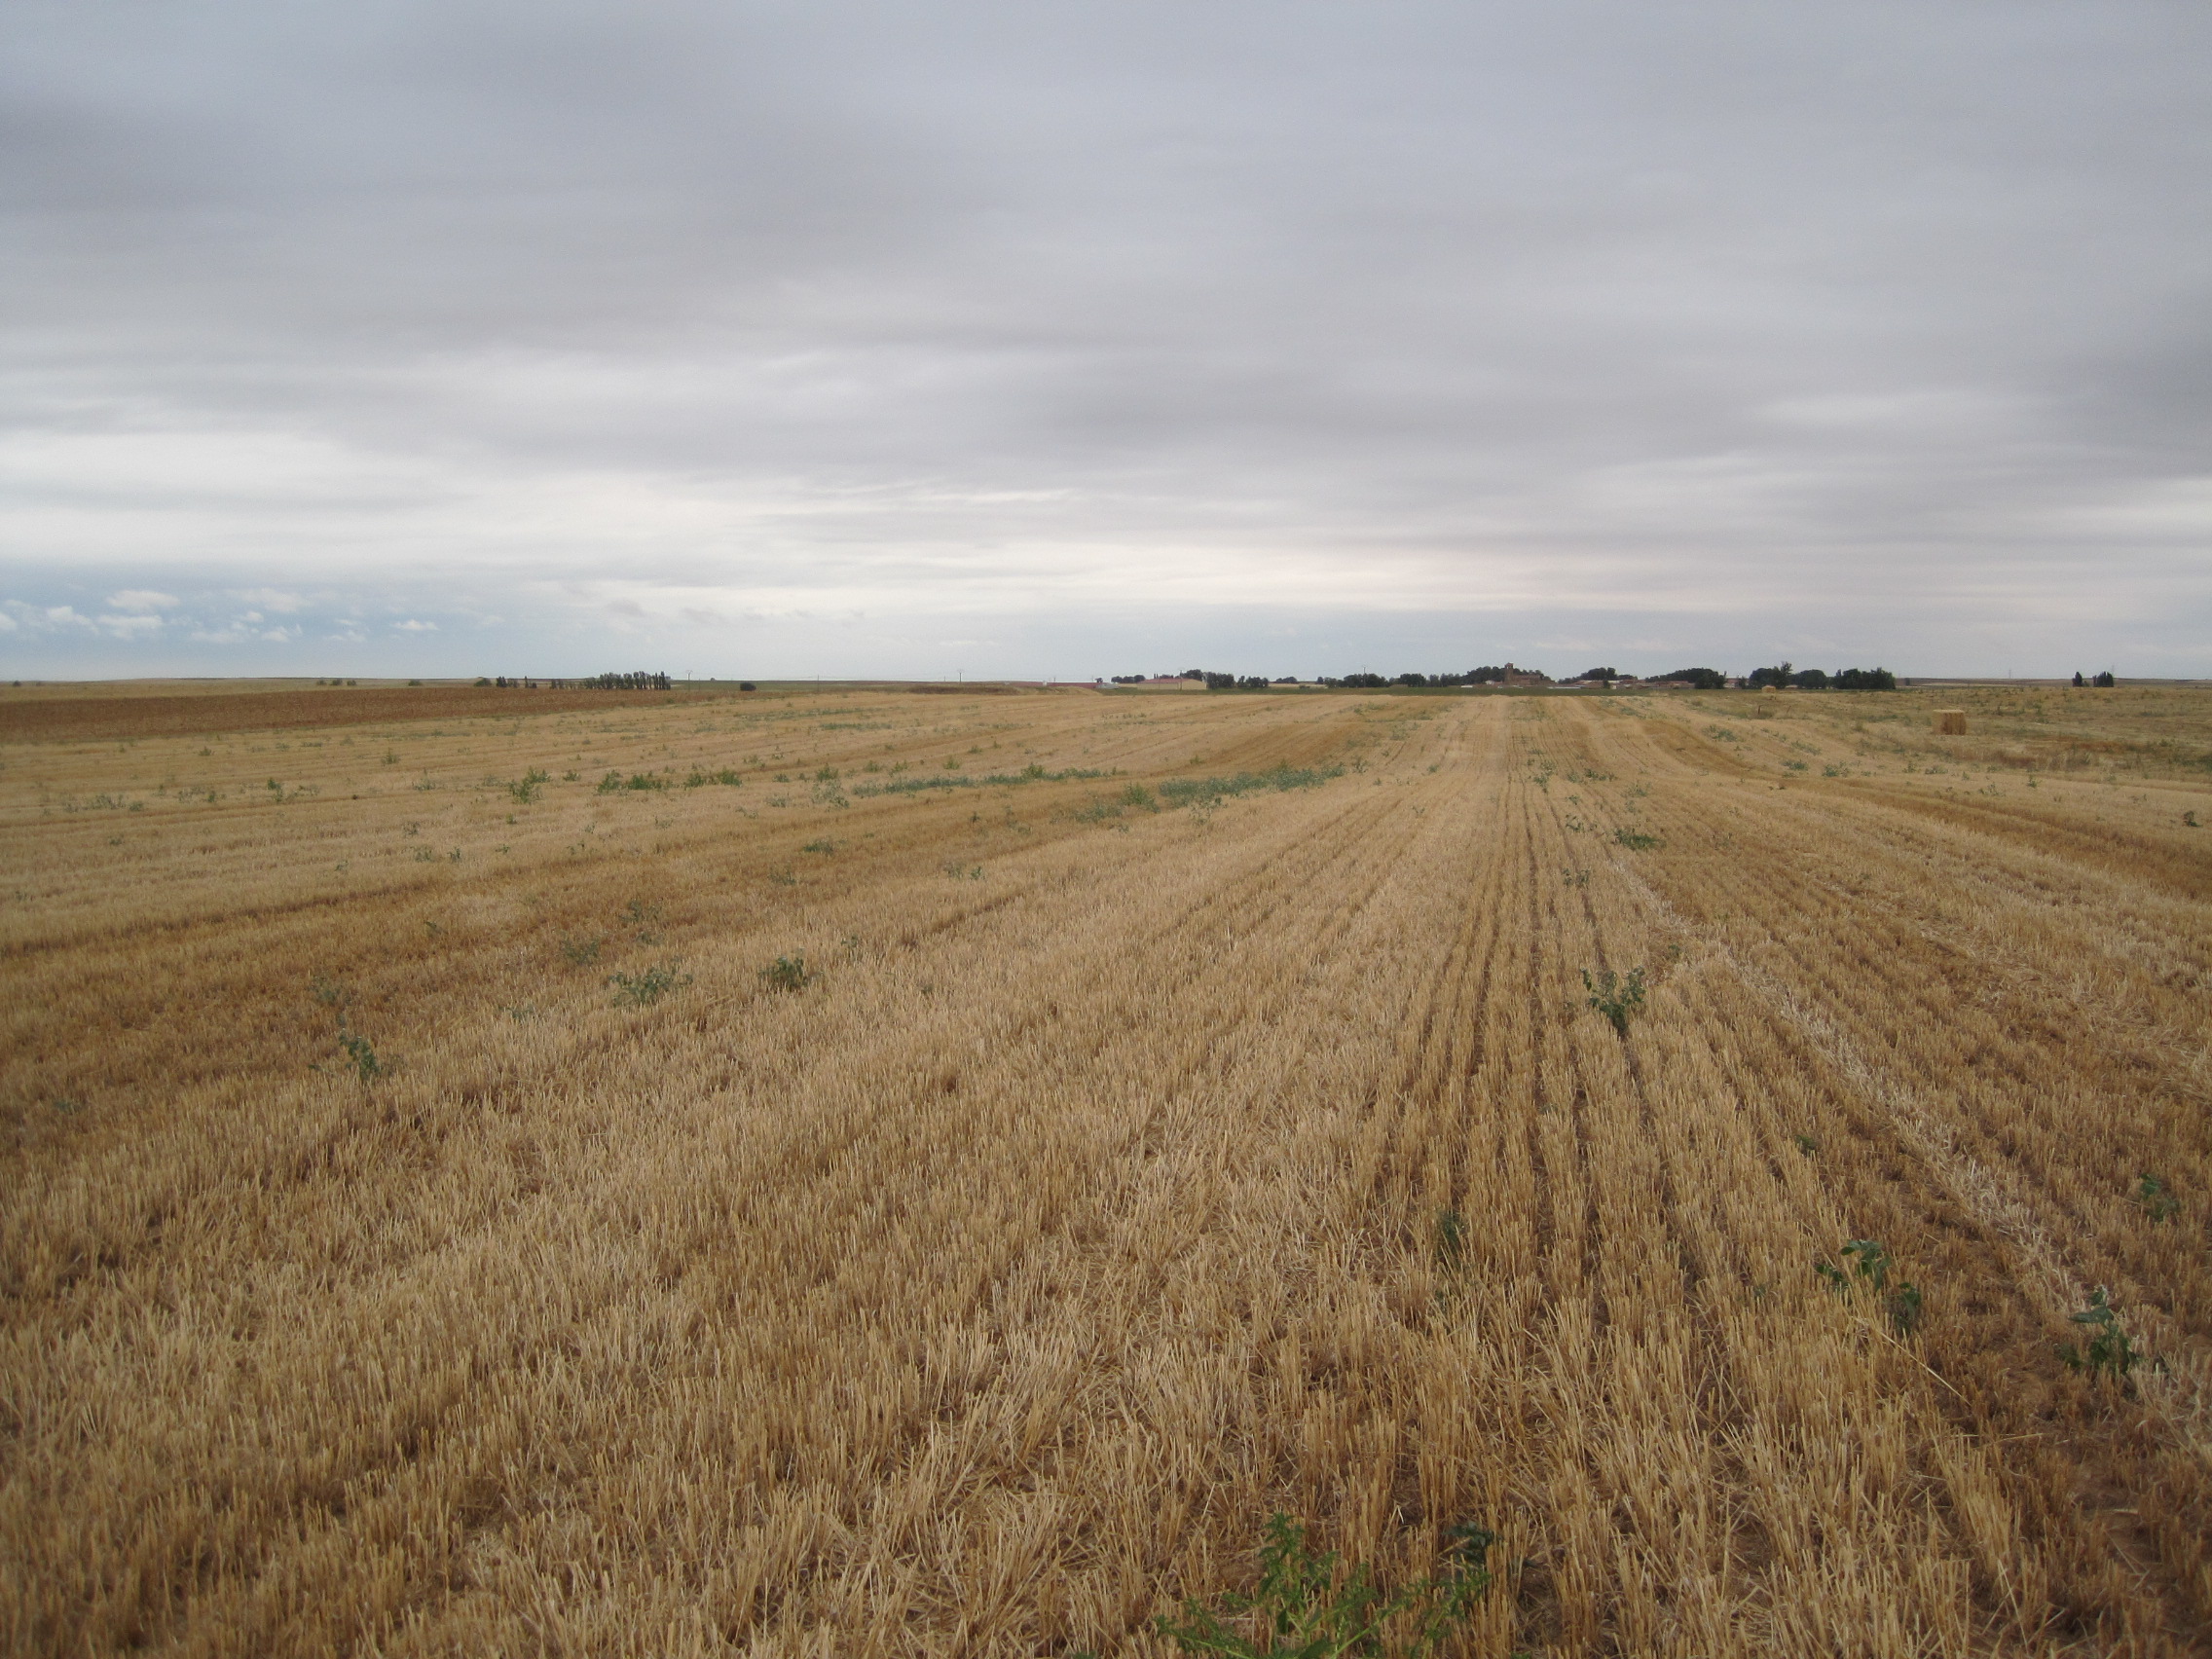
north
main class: Cropland
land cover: Barley
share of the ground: < 10 %
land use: Agriculture (excluding fallow land and kitchen gardens)
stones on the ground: < 10 %
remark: Harvested field
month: July
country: ES
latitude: 41.9743
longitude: -5.4493
